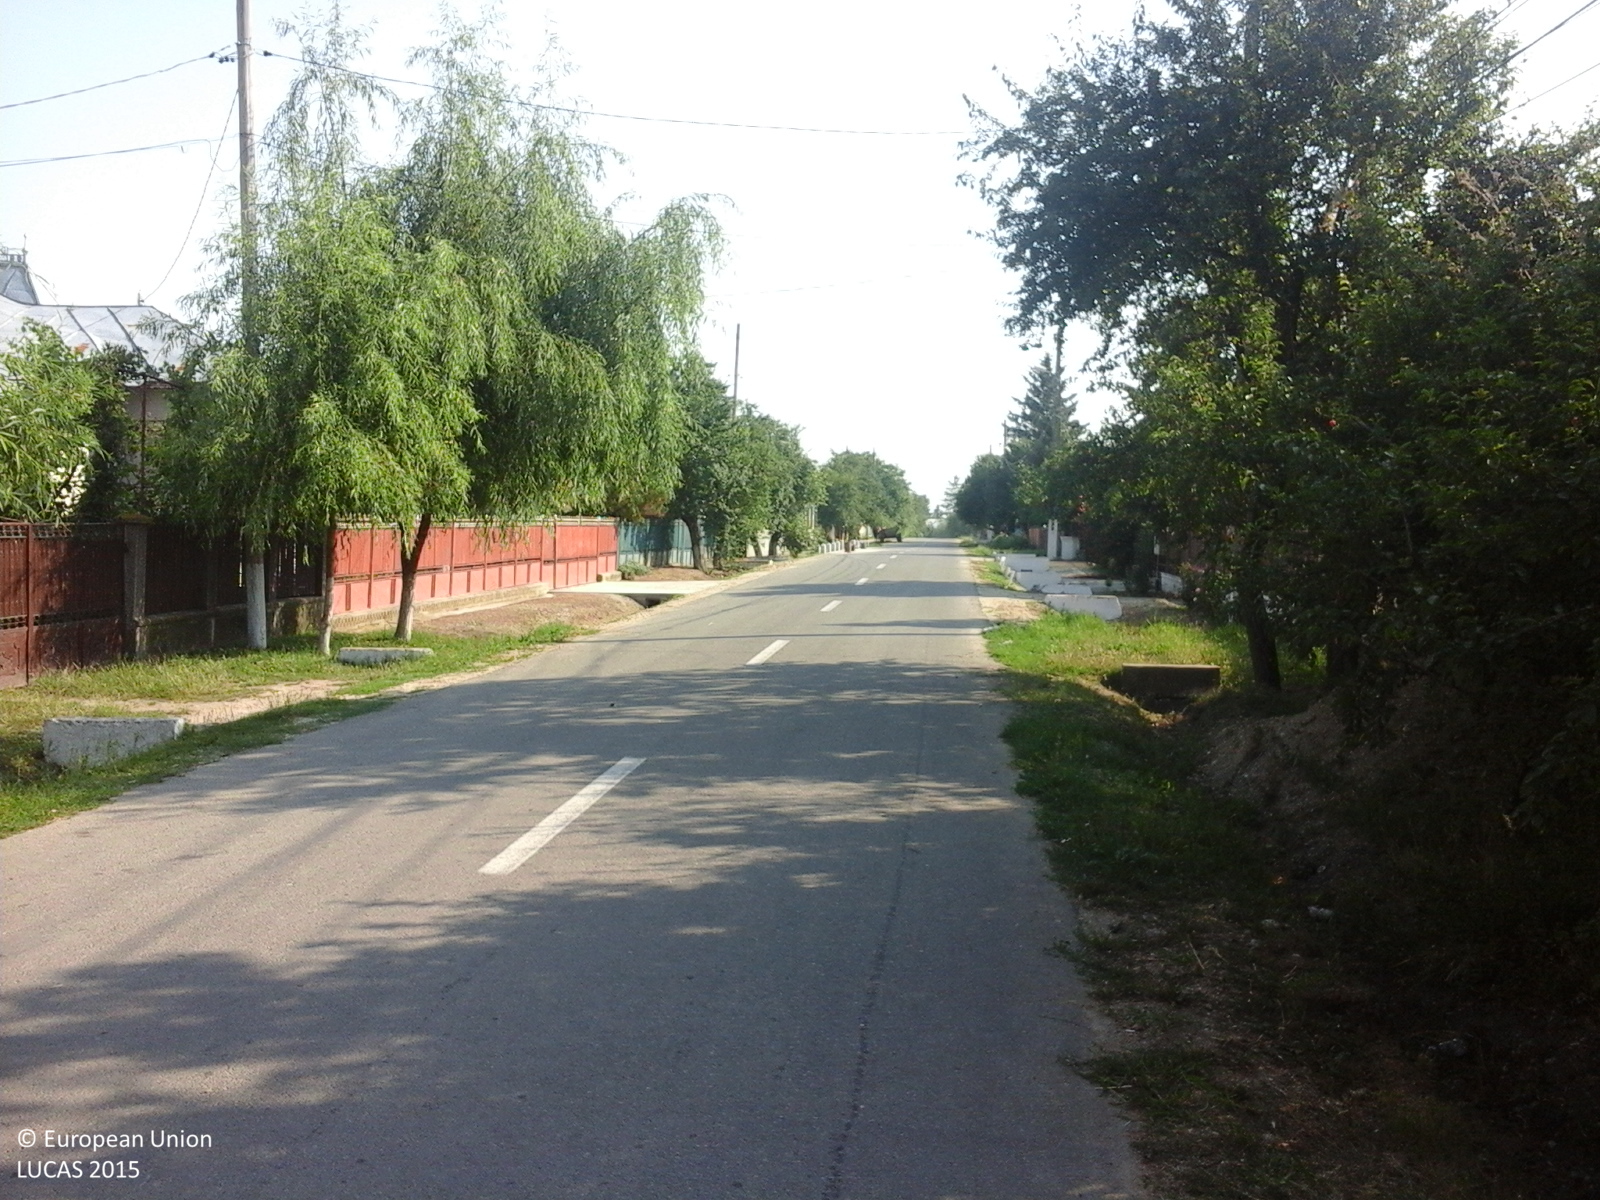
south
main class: Cropland
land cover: Apple fruit
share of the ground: > 75 %
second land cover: Grassland without tree/shrub cover
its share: > 75 %
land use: Agriculture (excluding fallow land and kitchen gardens)
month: July
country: RO
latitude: 44.5572
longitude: 25.5918
